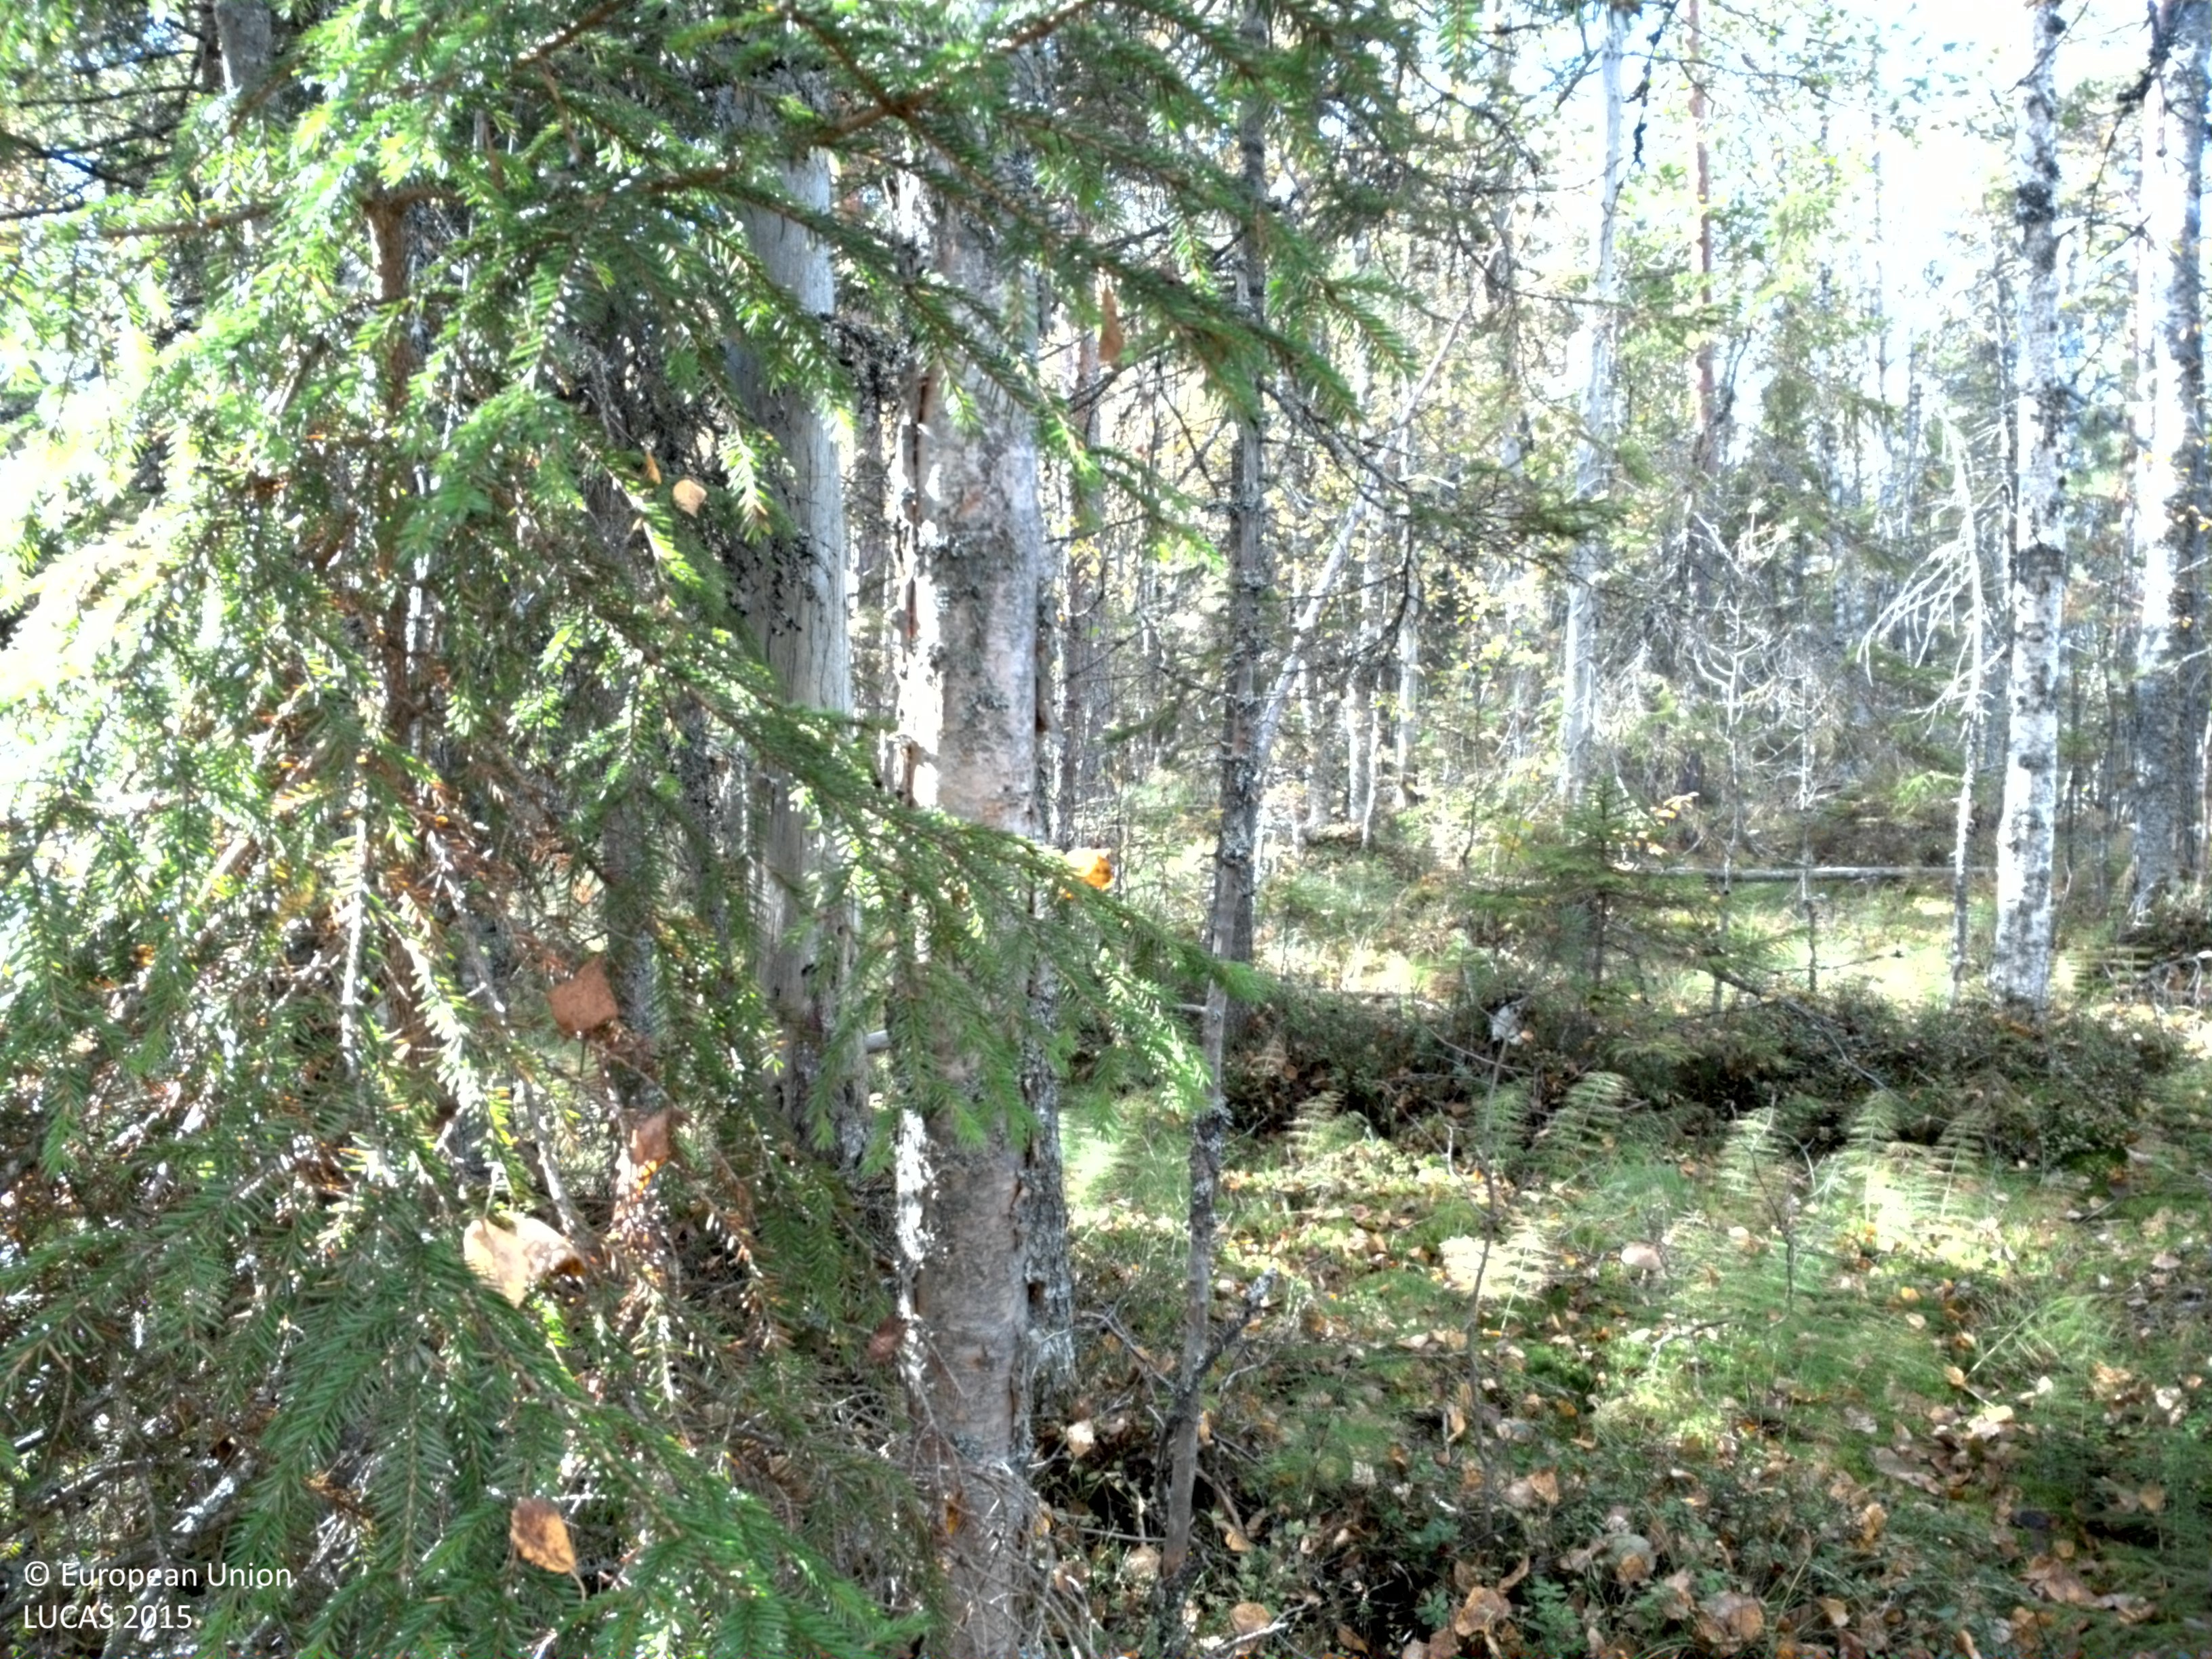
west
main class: Woodland
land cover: Spruce dominated mixed woodland
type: mire and swamp forests
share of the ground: 50 - 75 %
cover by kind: coniferous forest trees 45 %, lichens and mosses 40 %, broadleaved forest trees 15 %
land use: Forestry
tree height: > 5 m
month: September
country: SE
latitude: 60.1381
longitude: 16.5260
